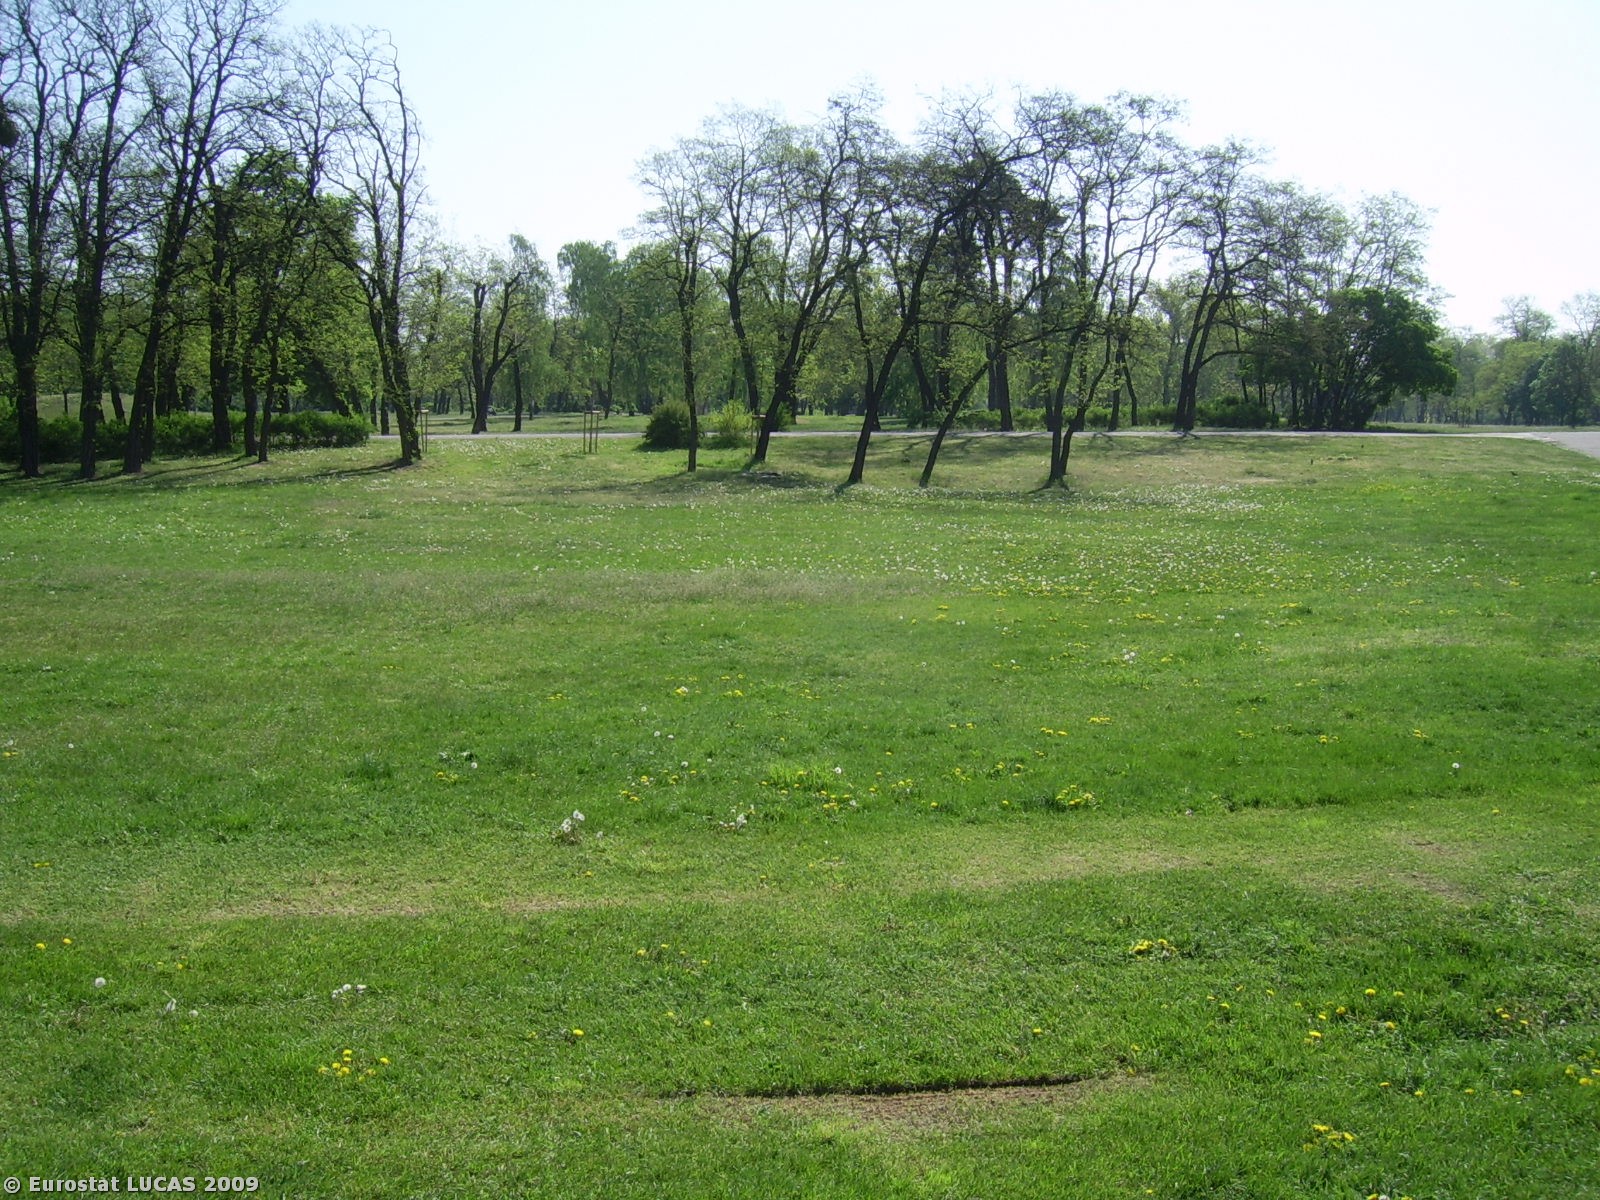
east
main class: Grassland
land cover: Grassland without tree/shrub cover
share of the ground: > 75 %
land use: Amenities, museums, leisure
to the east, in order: Grassland without tree/shrub cover; Grassland with sparse tree/shrub cover; Paved roads, cycling and walking lanes; Grassland with sparse tree/shrub cover; Paved roads, cycling and walking lanes; Grassland with sparse tree/shrub cover; Paved roads, cycling and walking lanes
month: May
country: PL
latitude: 52.4076
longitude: 16.9627
